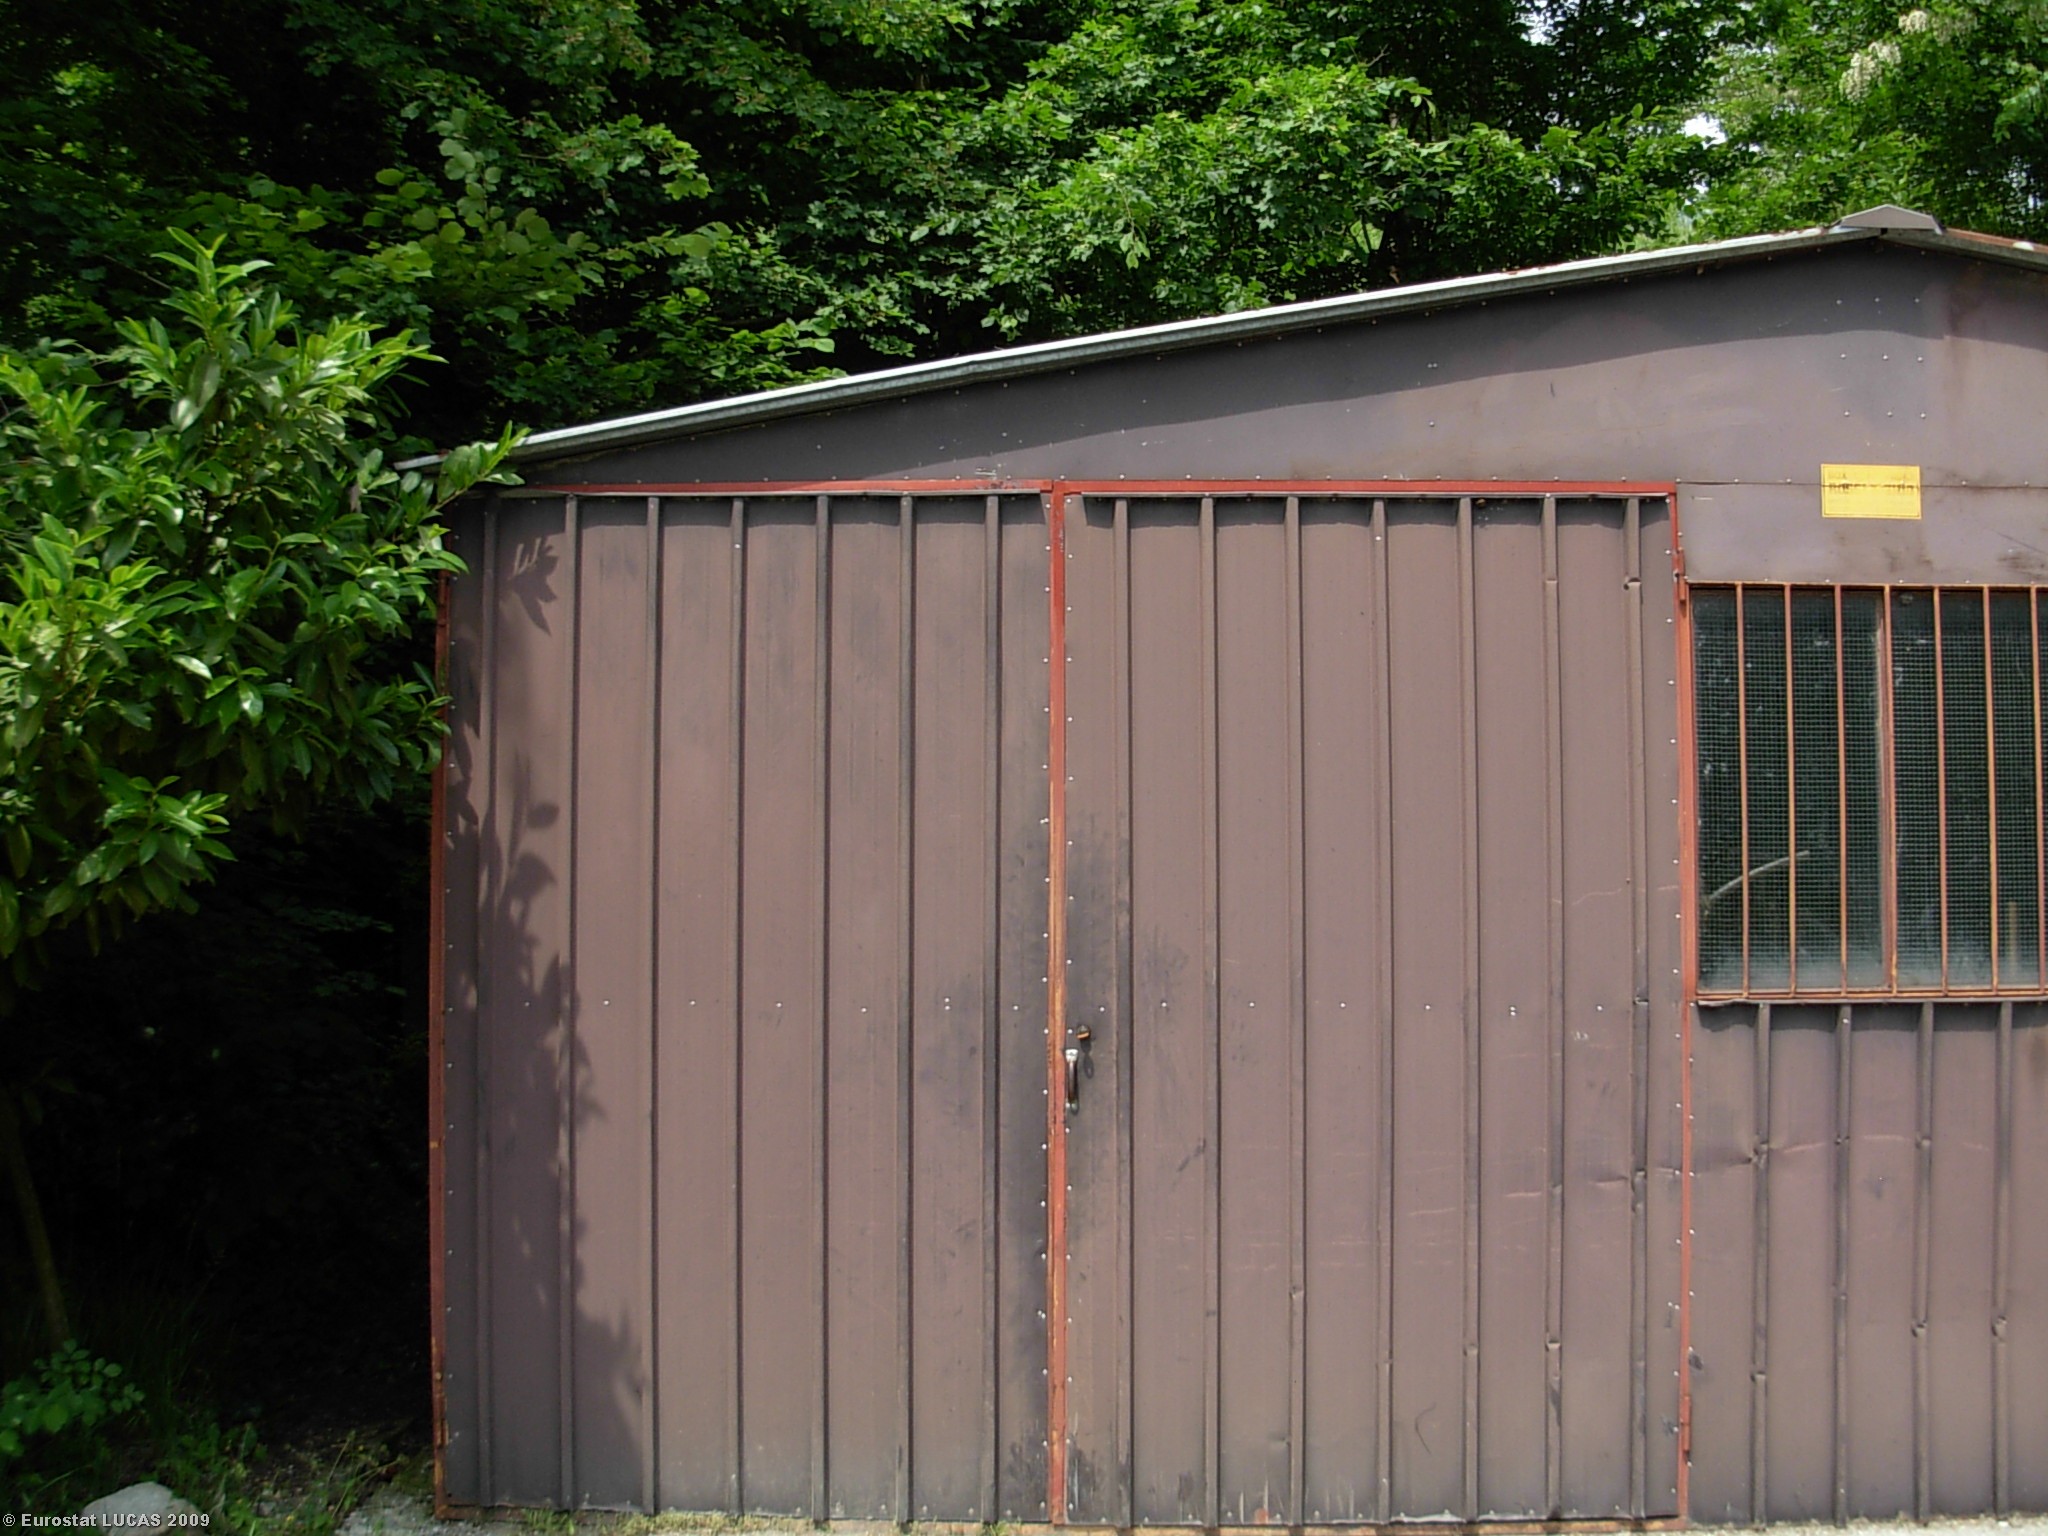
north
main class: Woodland
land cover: Broadleaved woodland
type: mountainous beech forest
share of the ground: > 75 %
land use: Unused
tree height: > 5 m
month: May
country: IT
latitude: 45.5580
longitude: 10.3197
